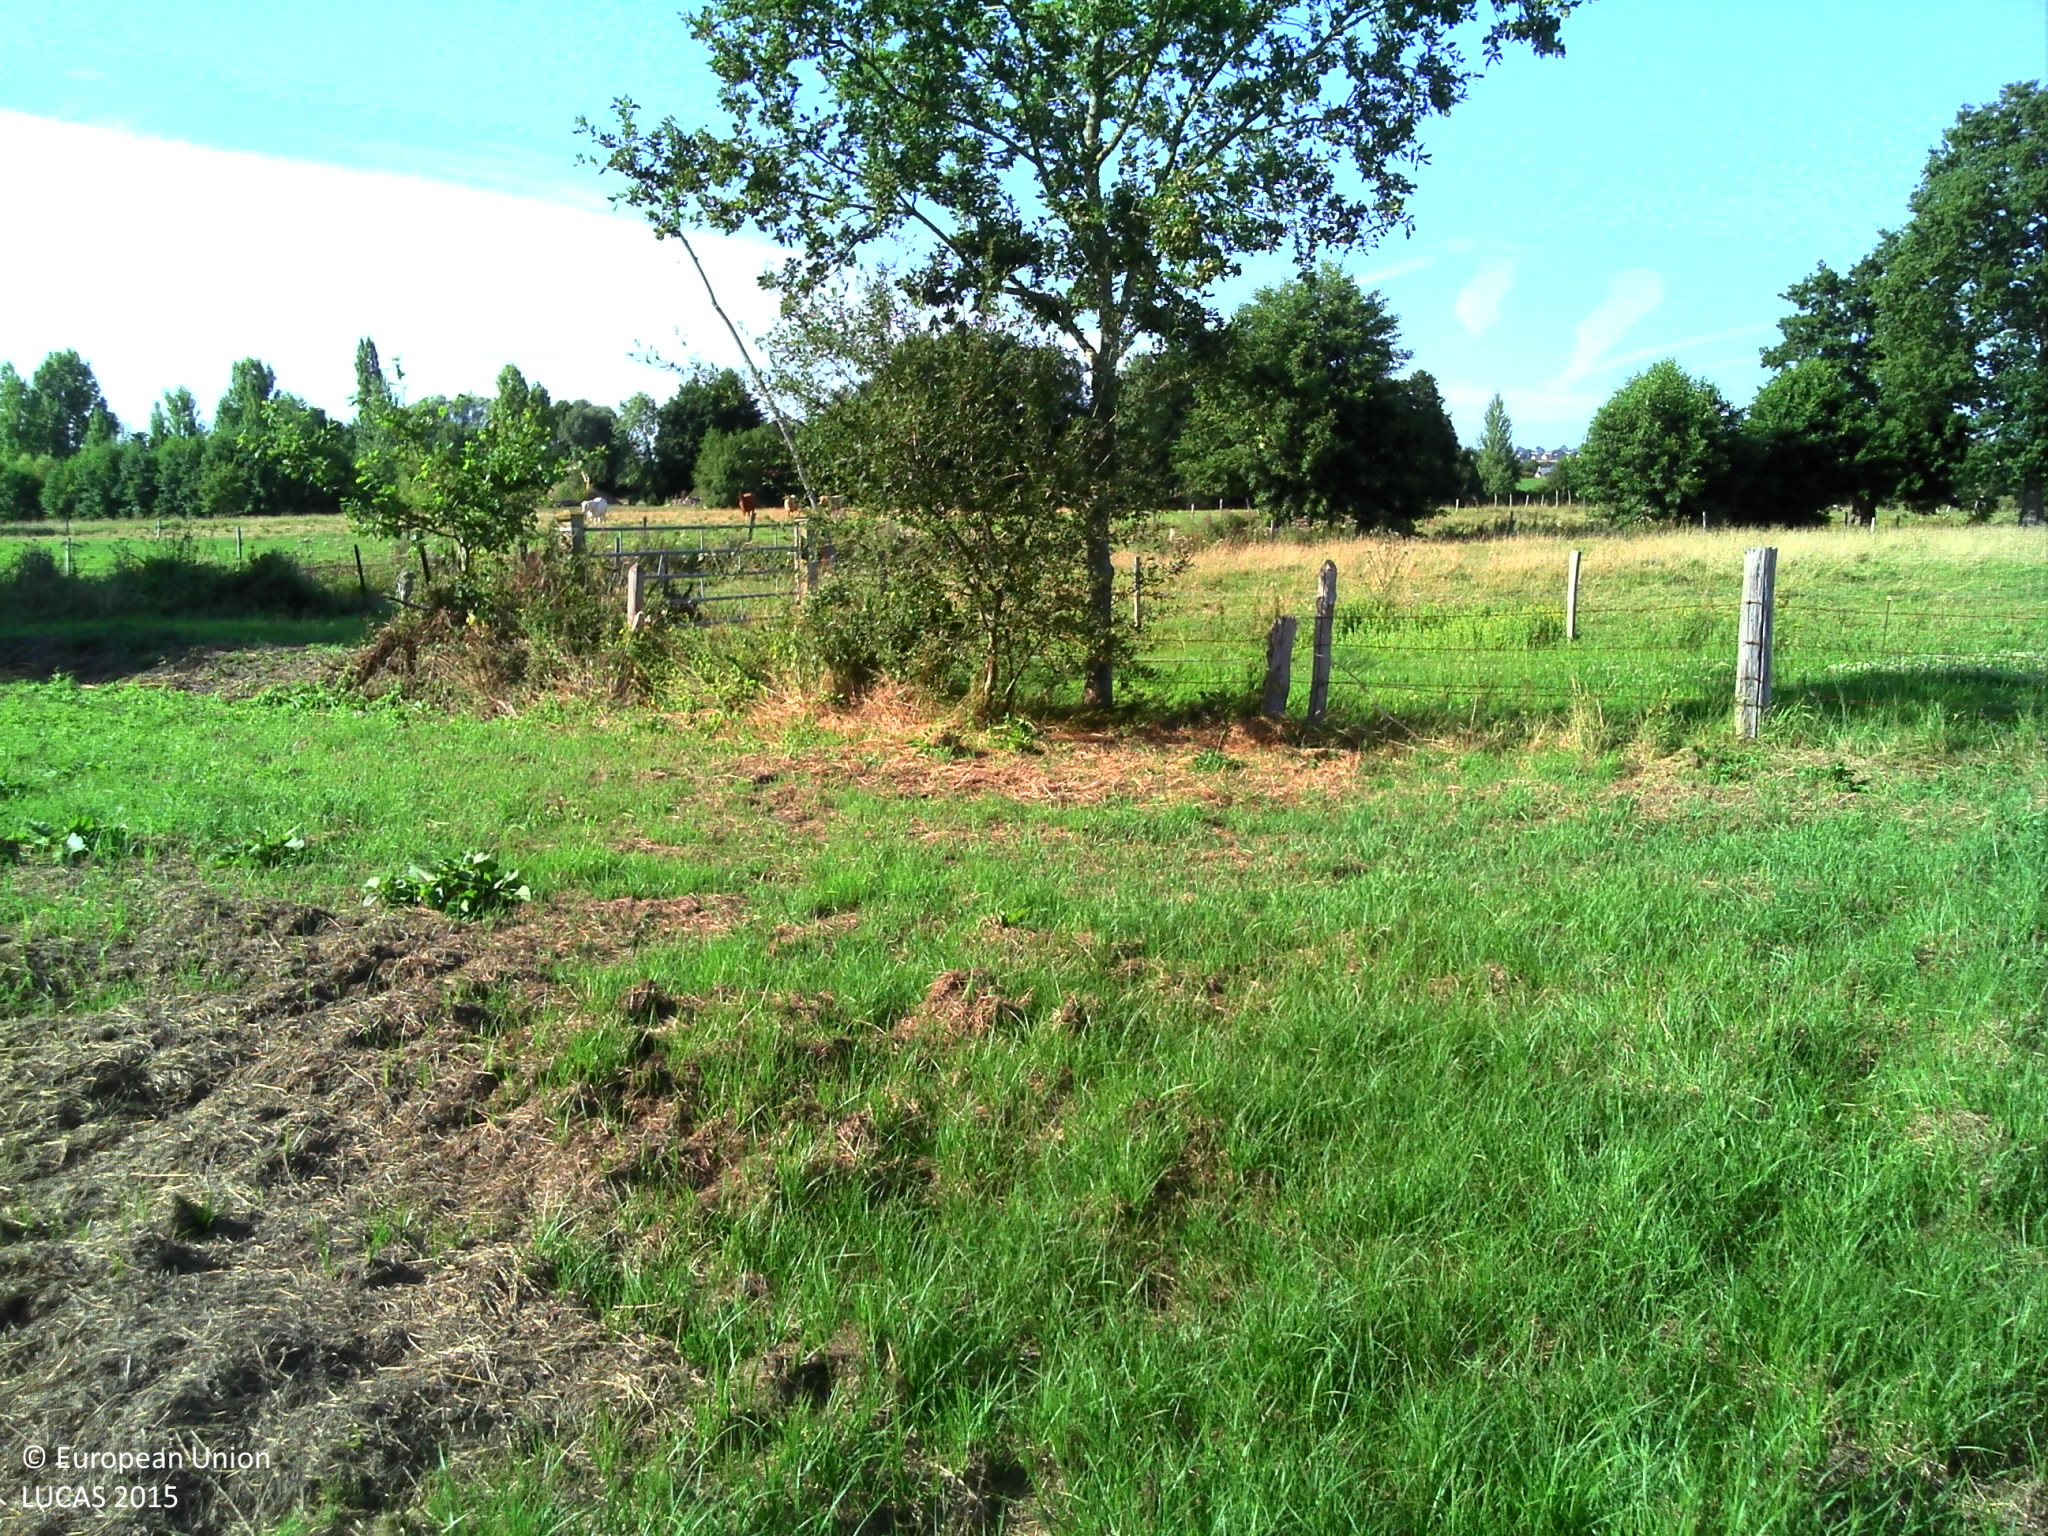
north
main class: Grassland
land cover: Grassland without tree/shrub cover
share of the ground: > 75 %
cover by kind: herbaceous plants 100 %
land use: Agriculture (excluding fallow land and kitchen gardens)
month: August
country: FR
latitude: 48.6196
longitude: -1.3181
